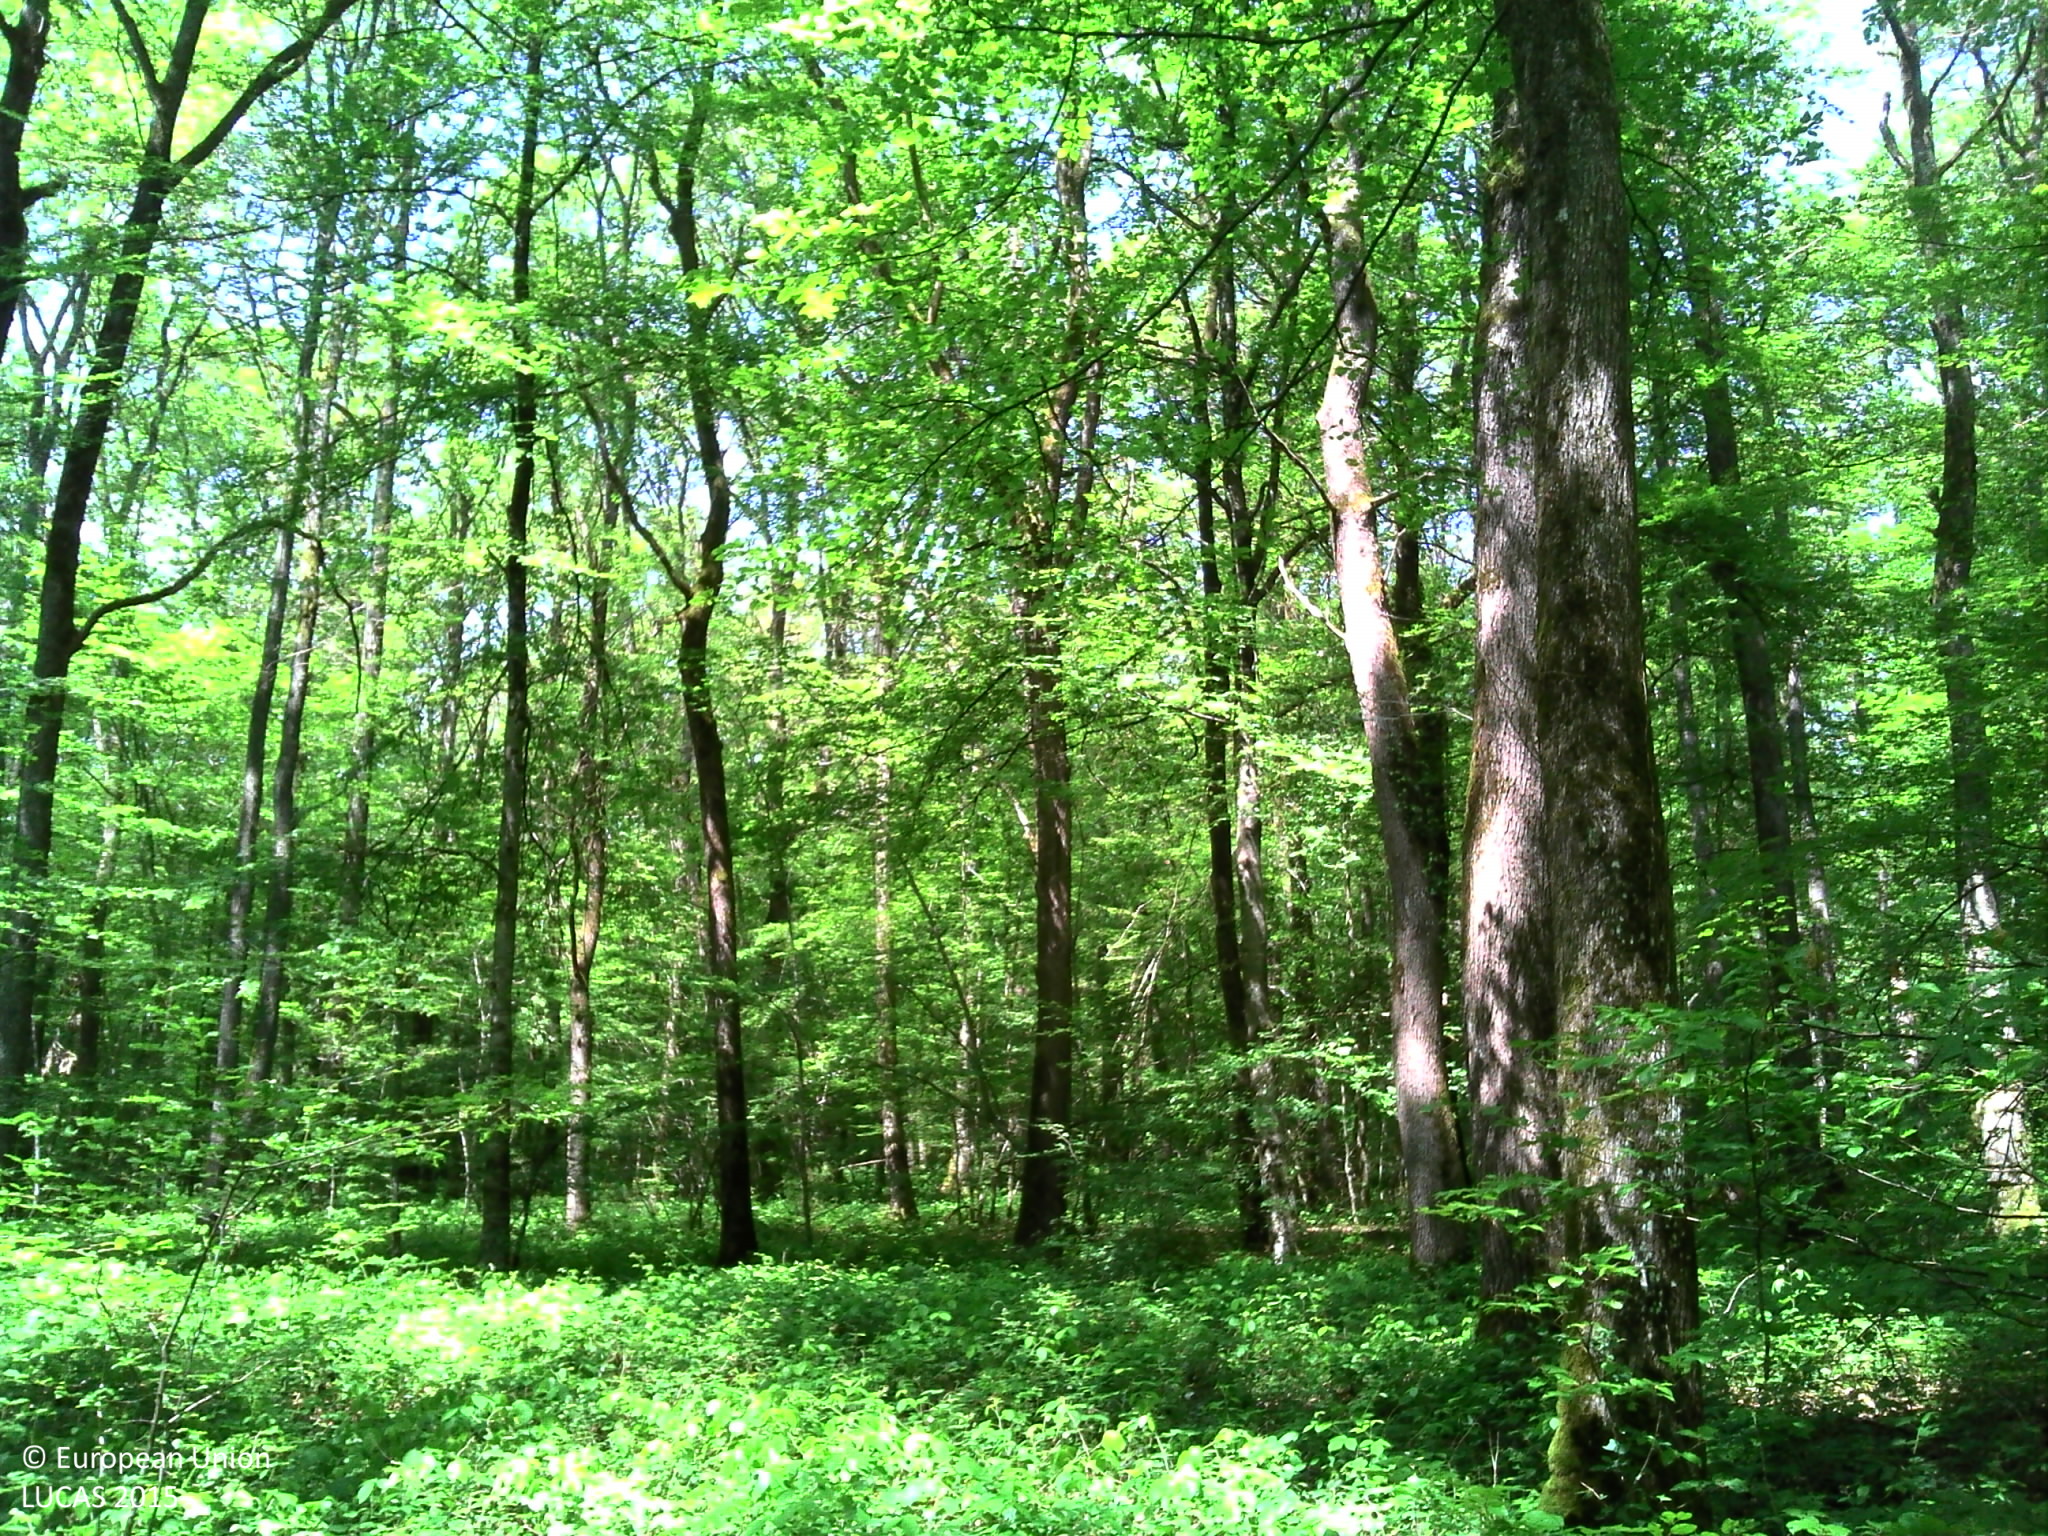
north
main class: Woodland
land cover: Broadleaved woodland
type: beech forest
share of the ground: > 75 %
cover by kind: broadleaved forest trees 90 %, shrubs 10 %
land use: Forestry
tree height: > 5 m
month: May
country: FR
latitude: 47.2520
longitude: 2.8725
